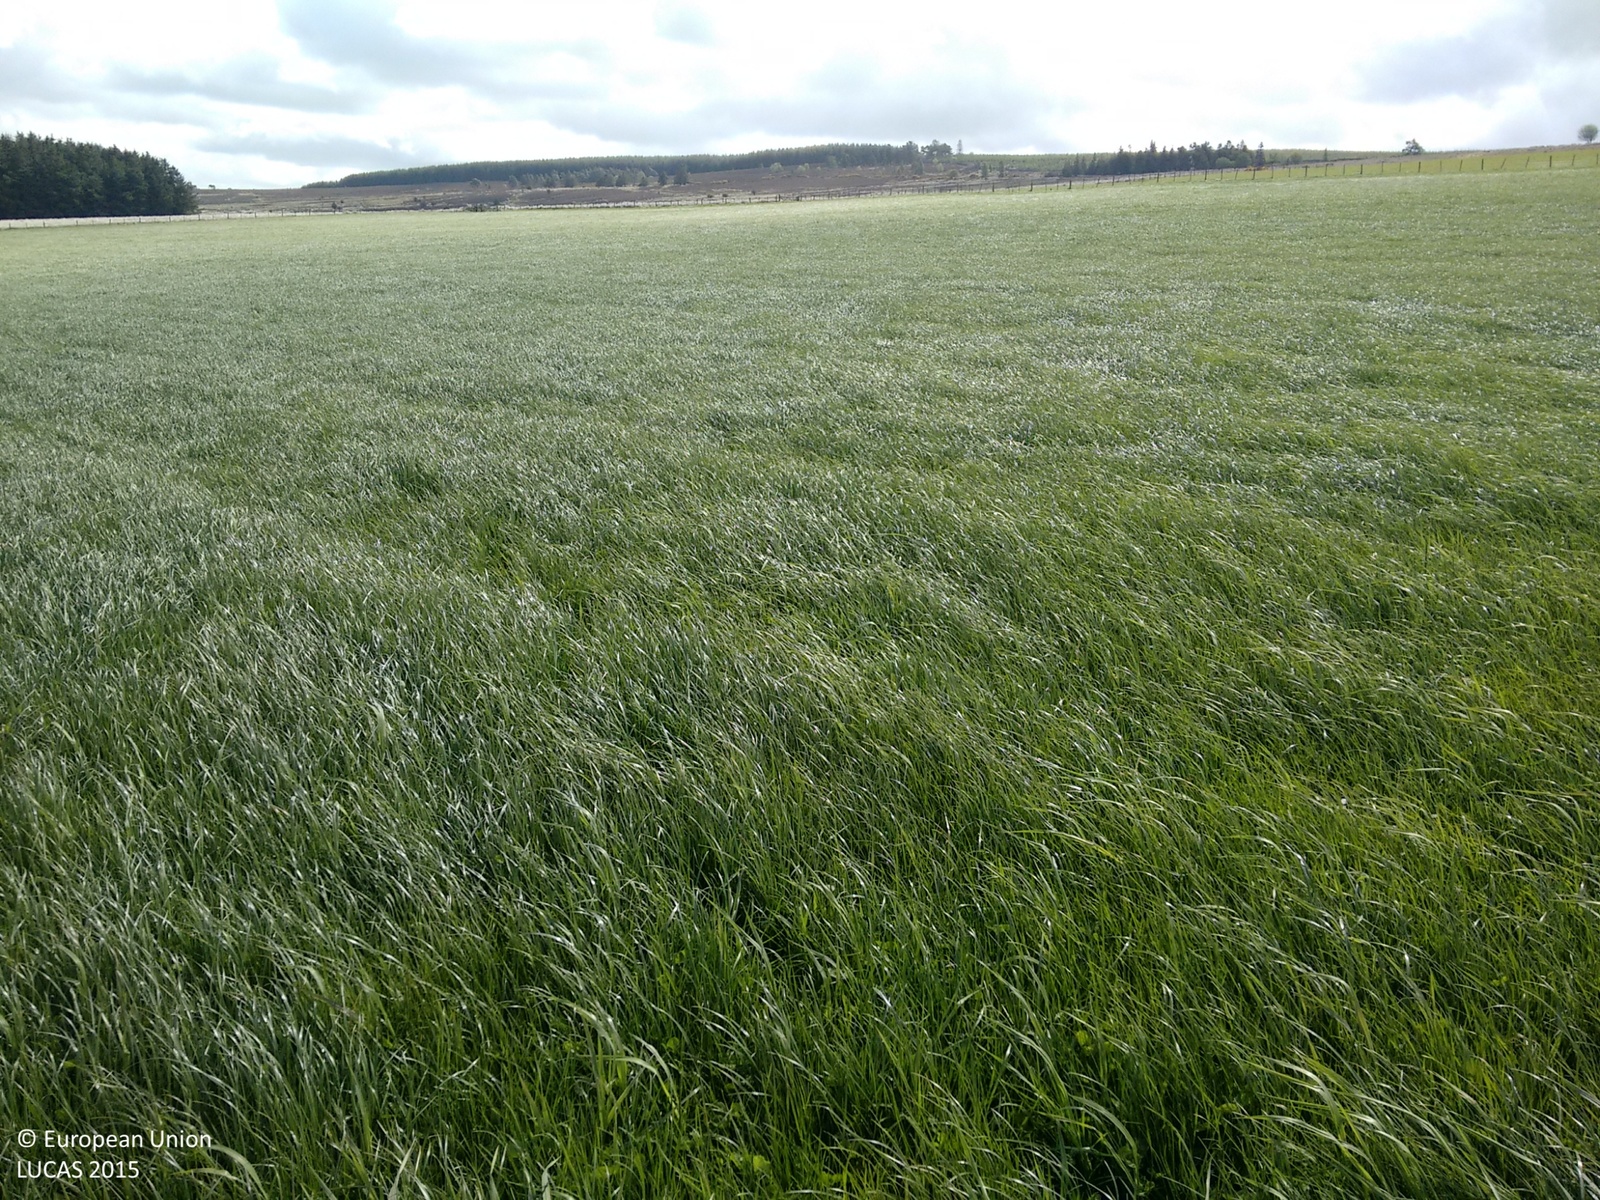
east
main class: Grassland
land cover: Grassland without tree/shrub cover
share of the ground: > 75 %
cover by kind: herbaceous plants 100 %
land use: Agriculture (excluding fallow land and kitchen gardens)
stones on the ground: < 10 %
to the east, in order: Grassland without tree/shrub cover; Fences; Grassland without tree/shrub cover; Tracks; Grassland without tree/shrub cover; Fences; Grassland without tree/shrub cover
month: June
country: GB
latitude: 55.4010
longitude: -2.5851
